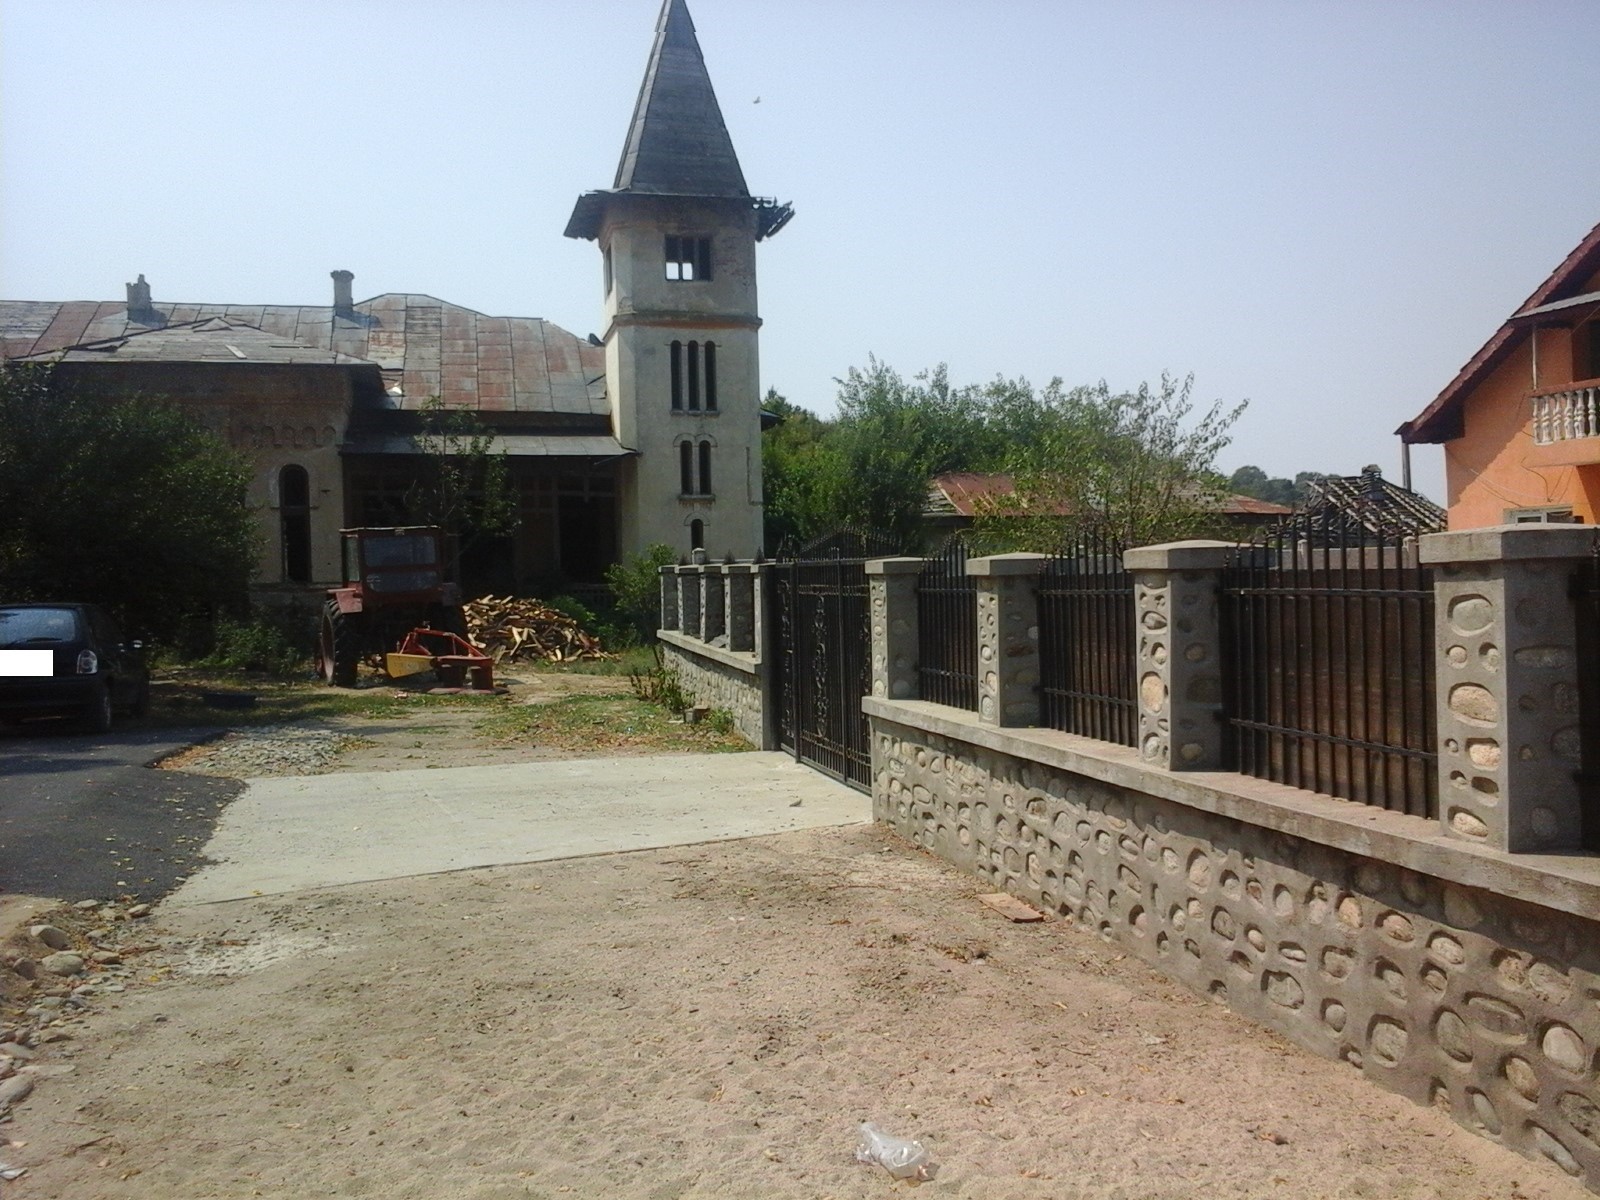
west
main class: Cropland
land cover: Other fresh vegetables
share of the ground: > 75 %
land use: Kitchen garden
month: August
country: RO
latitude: 44.5495
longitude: 23.7149
